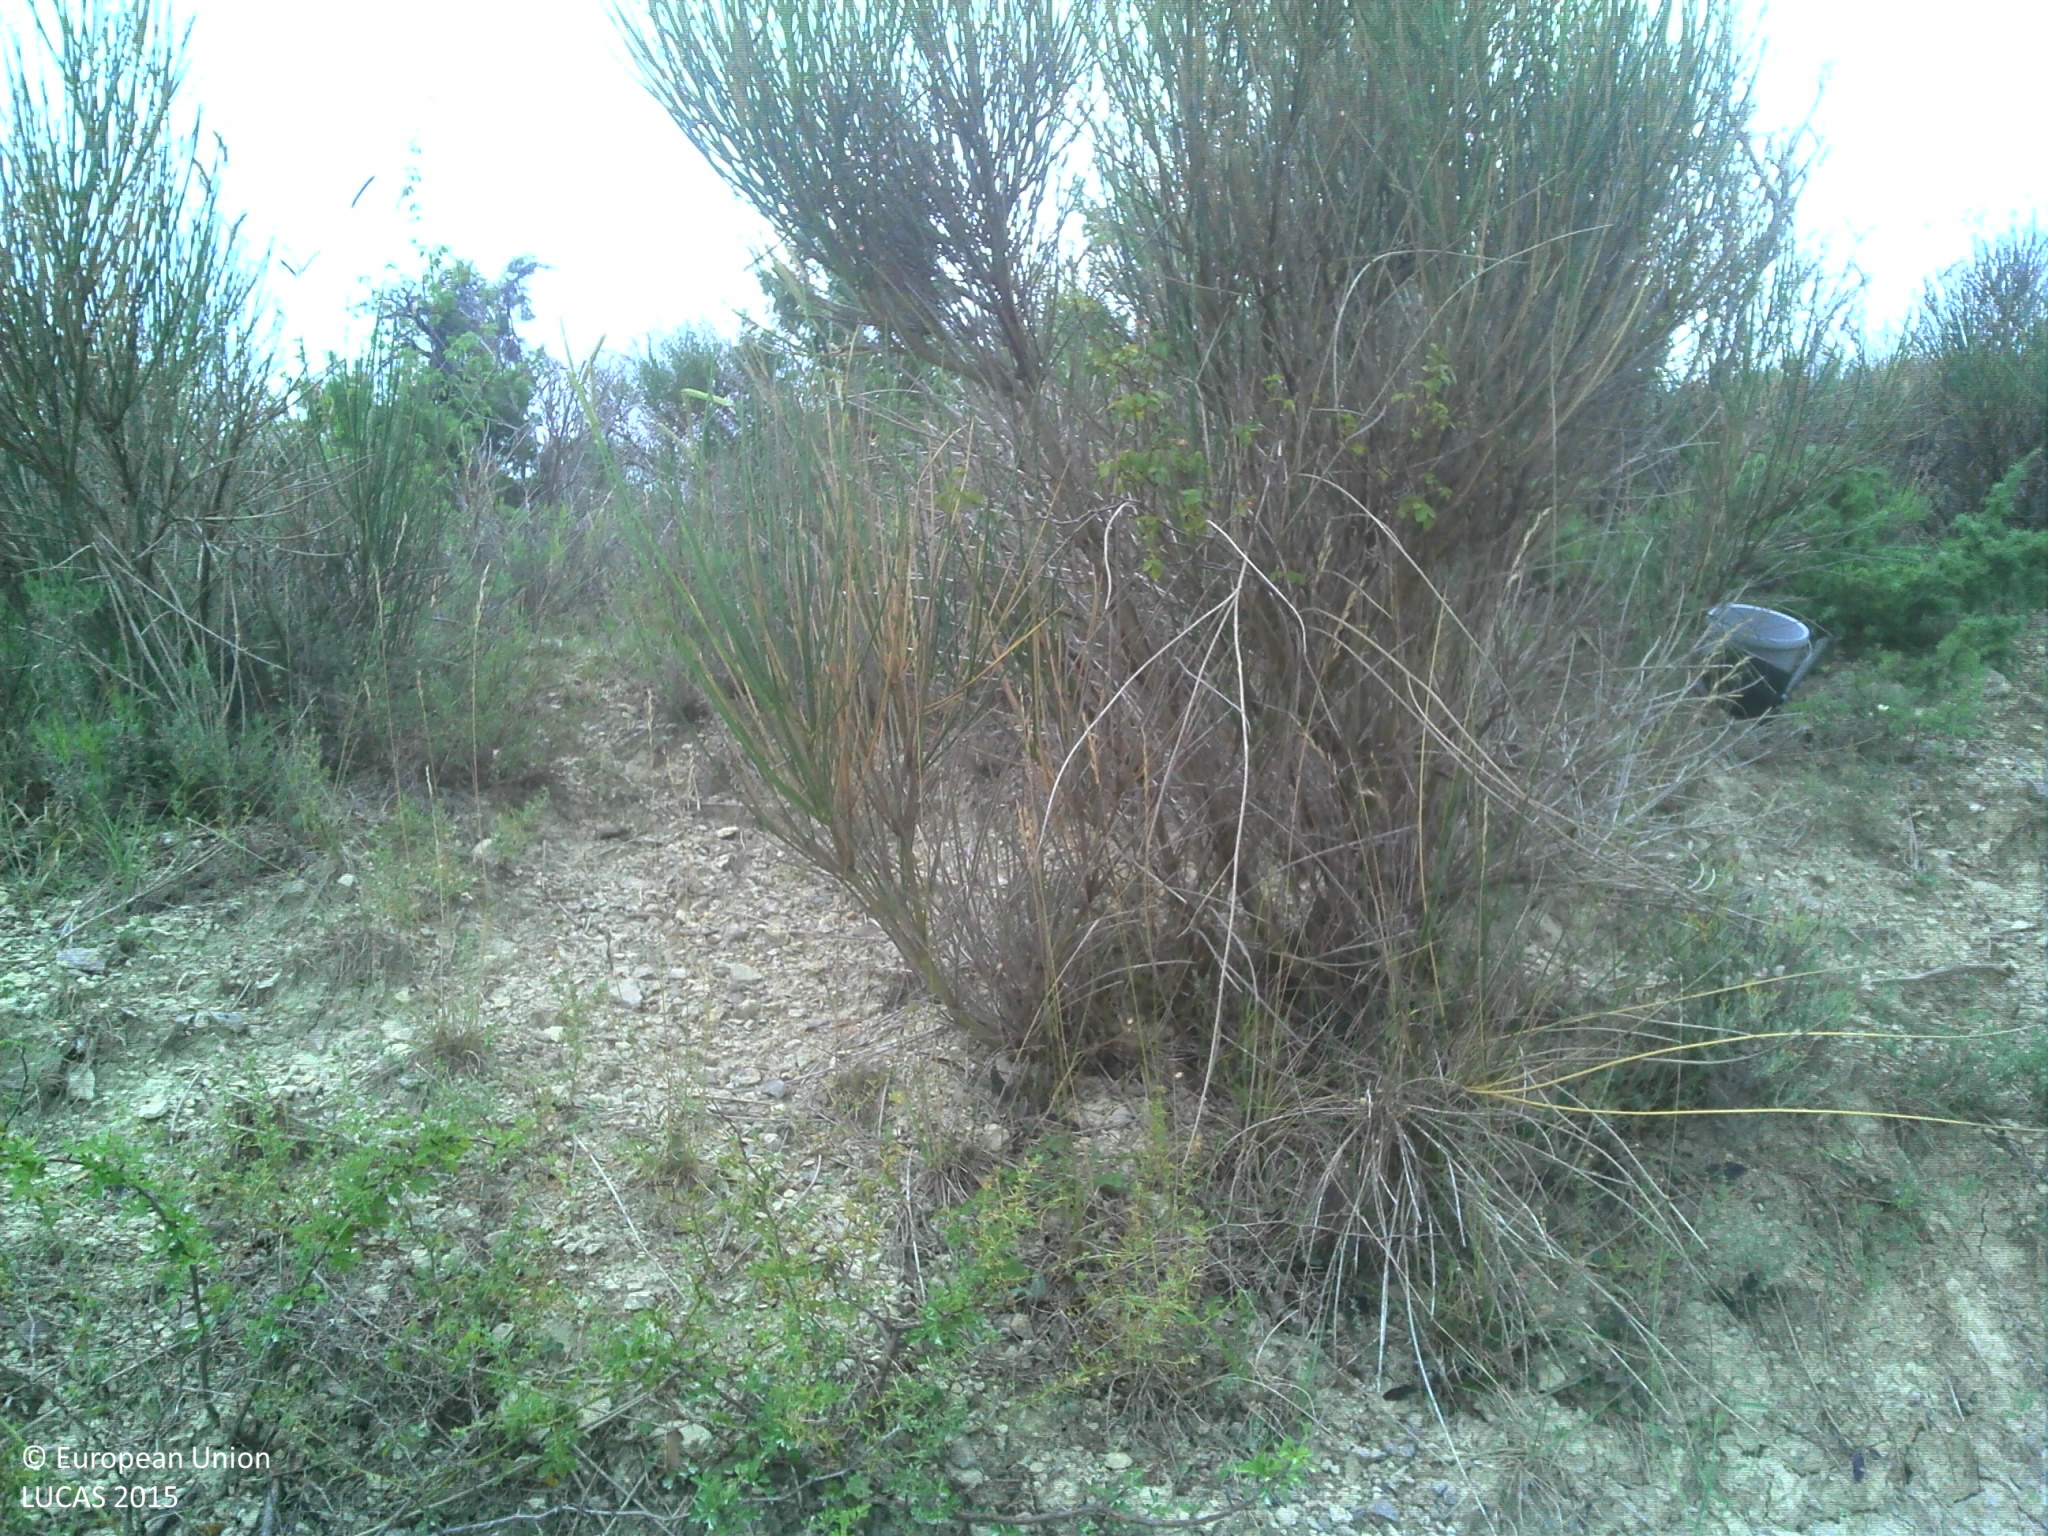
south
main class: Shrubland
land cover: Shrubland without tree cover
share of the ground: 50 - 75 %
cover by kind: shrubs 45 %, herbaceous plants 25 %, unconsolidated bare surface 20 %, consolidated bare surface 10 %
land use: Semi-natural and natural areas not in use
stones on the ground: > 50 %
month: July
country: FR
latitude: 43.9665
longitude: 5.5588
